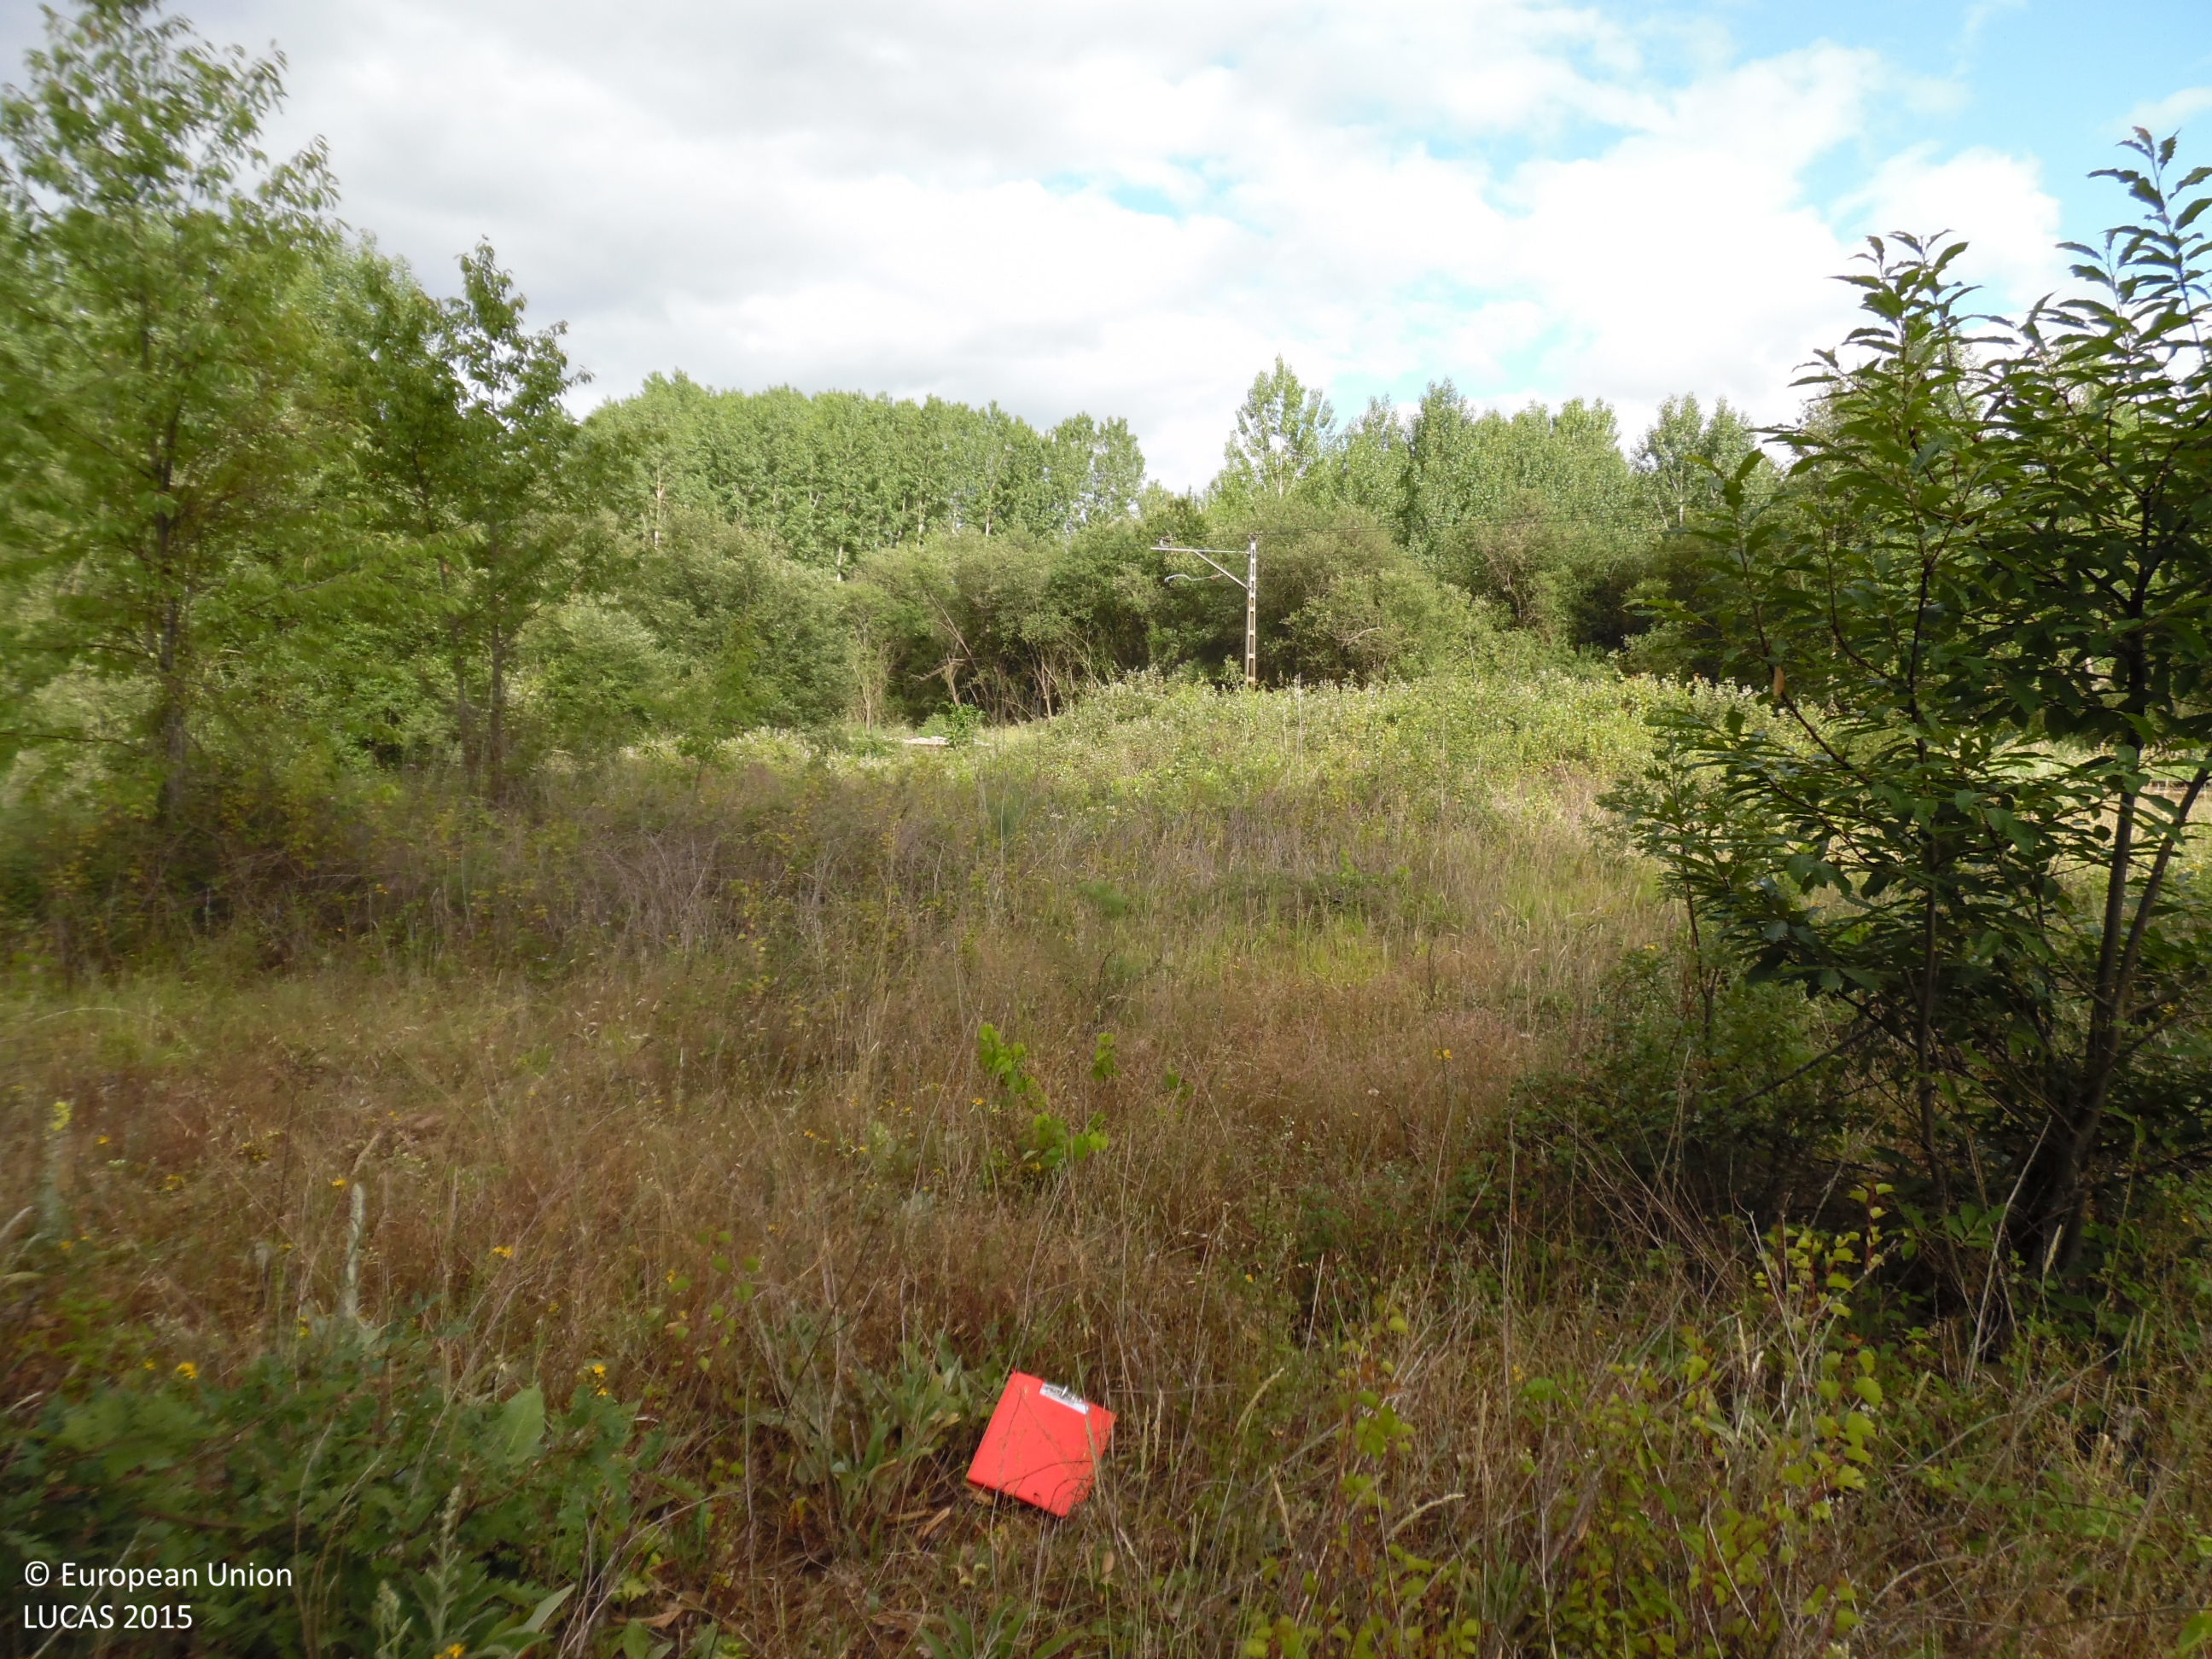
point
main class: Shrubland
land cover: Shrubland with sparse tree cover
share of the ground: > 75 %
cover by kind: shrubs 95 %, broadleaved forest trees 5 %
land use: Abandoned areas
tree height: > 5 m
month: June
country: ES
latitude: 42.5369
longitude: -6.7428
